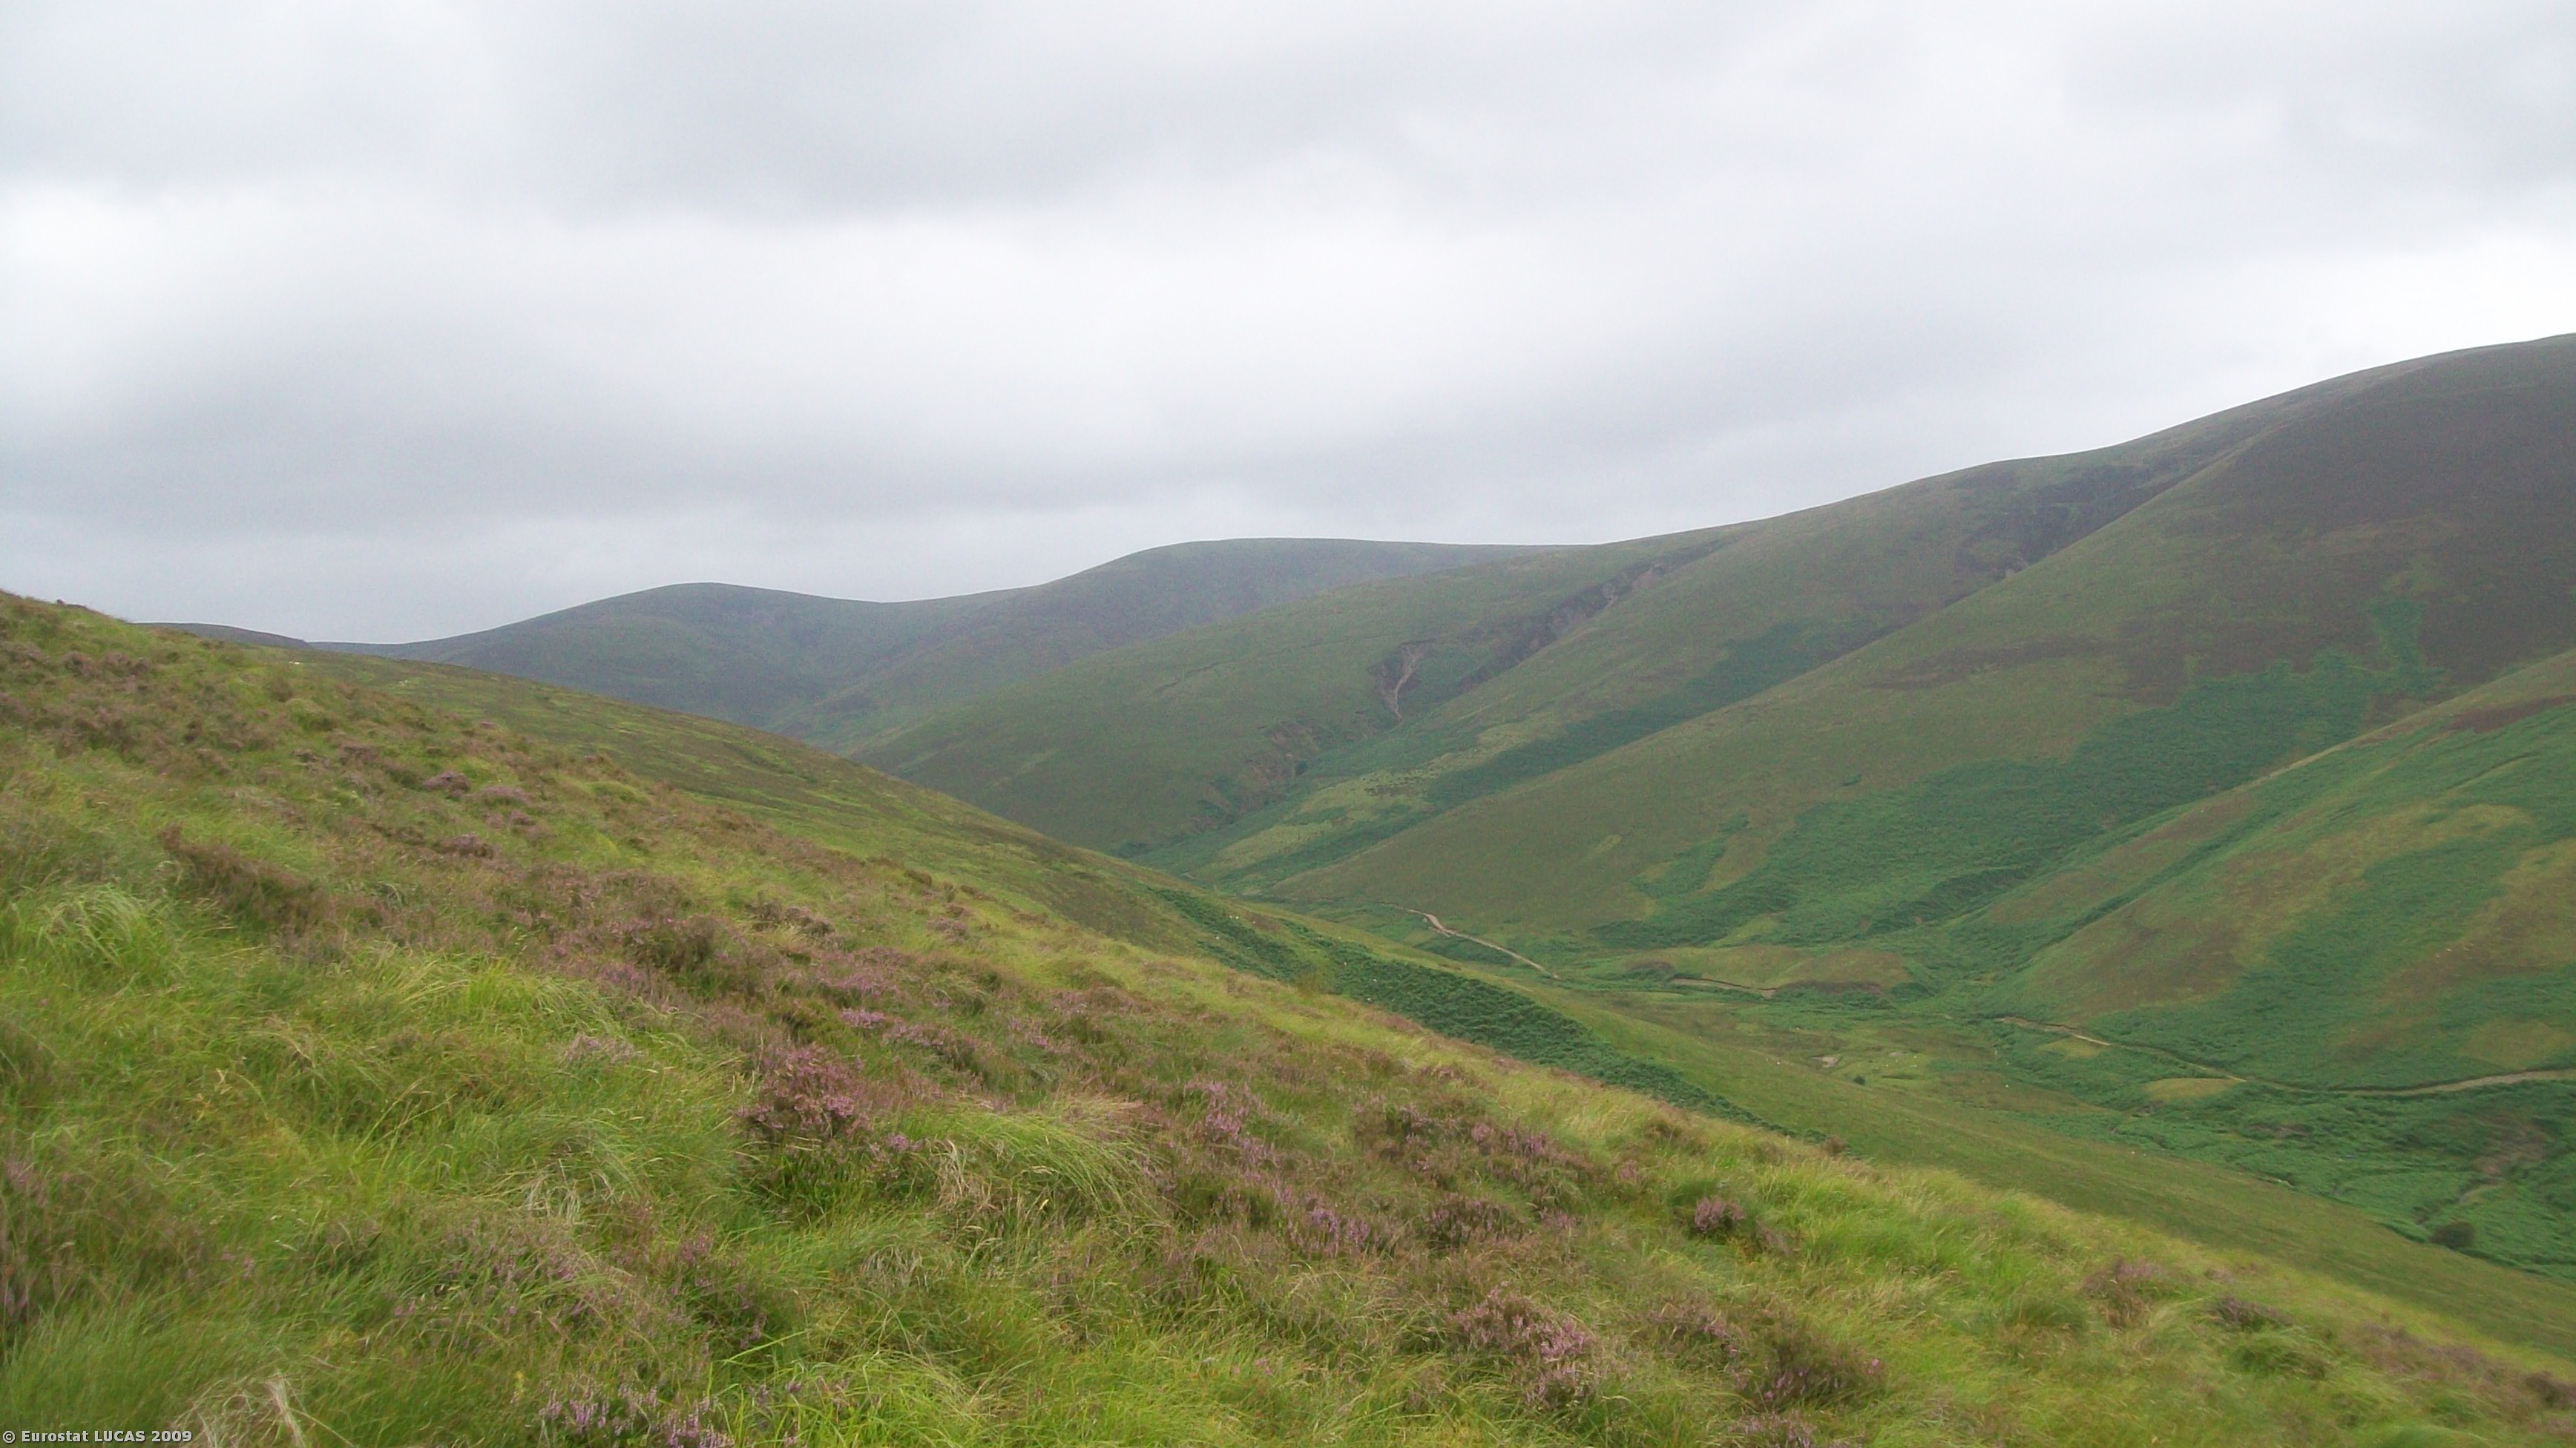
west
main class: Shrubland
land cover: Shrubland without tree cover
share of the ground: > 75 %
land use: Agriculture (excluding fallow land and kitchen gardens)
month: August
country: GB
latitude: 55.5109
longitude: -3.4588
